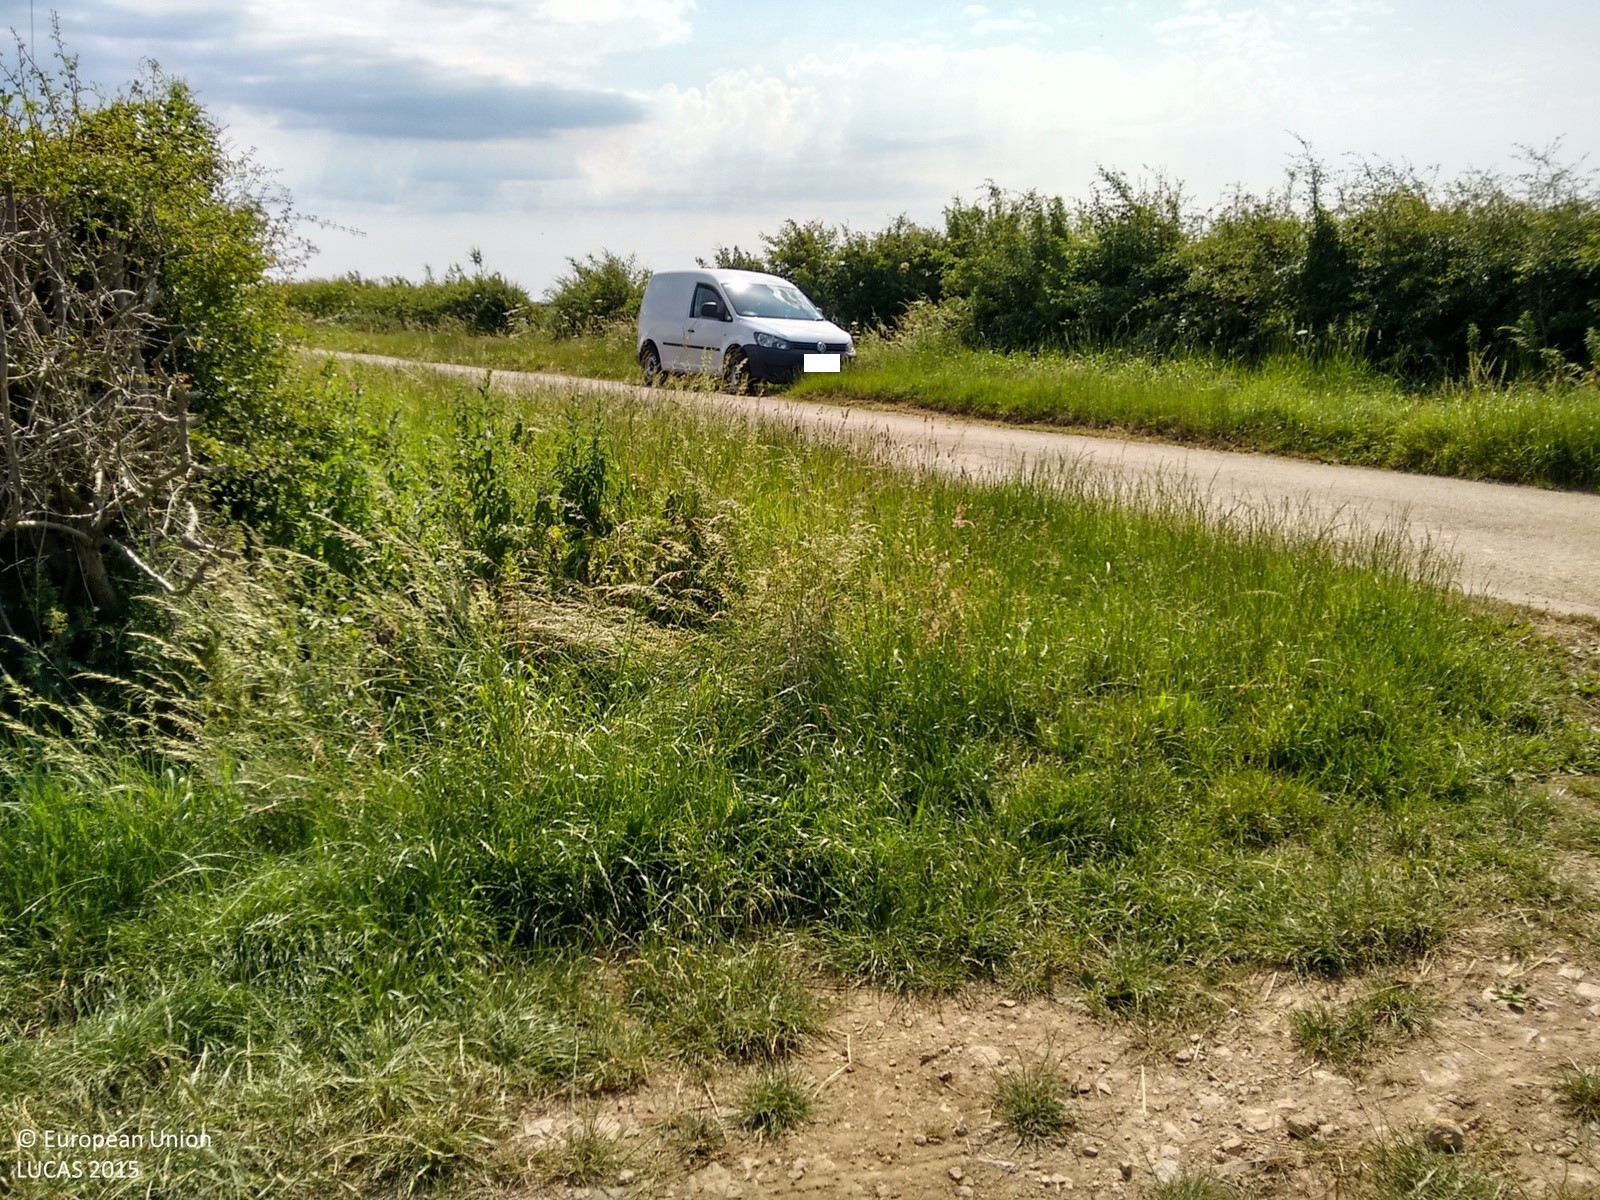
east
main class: Grassland
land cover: Grassland without tree/shrub cover
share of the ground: > 75 %
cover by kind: herbaceous plants 100 %
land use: Agriculture (excluding fallow land and kitchen gardens)
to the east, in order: Grassland without tree/shrub cover; Managed hedges; Ditches and canals; Fences; Grassland without tree/shrub cover
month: July
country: GB
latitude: 53.4005
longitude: -0.6728
